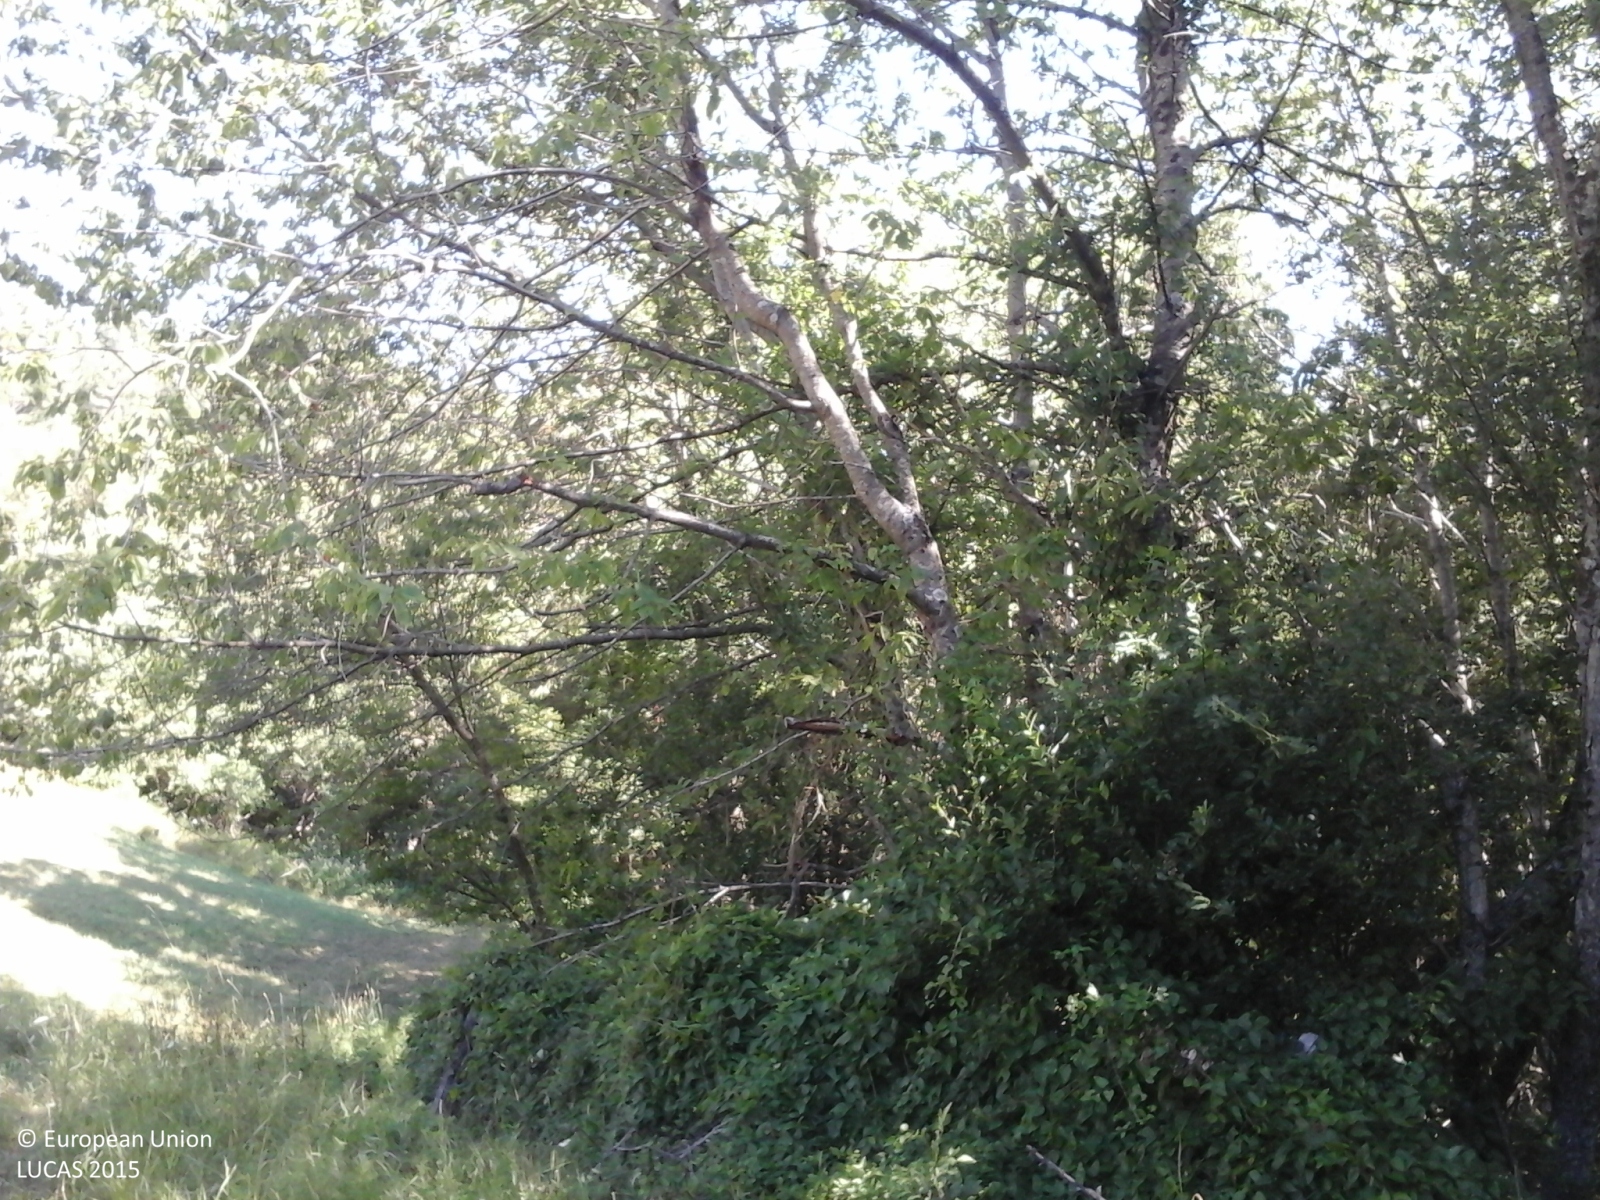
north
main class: Woodland
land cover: Broadleaved woodland
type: thermophilous deciduous forest
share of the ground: > 75 %
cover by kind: broadleaved forest trees 100 %
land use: Forestry
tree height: > 5 m
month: July
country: IT
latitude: 44.2404
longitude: 10.6371
